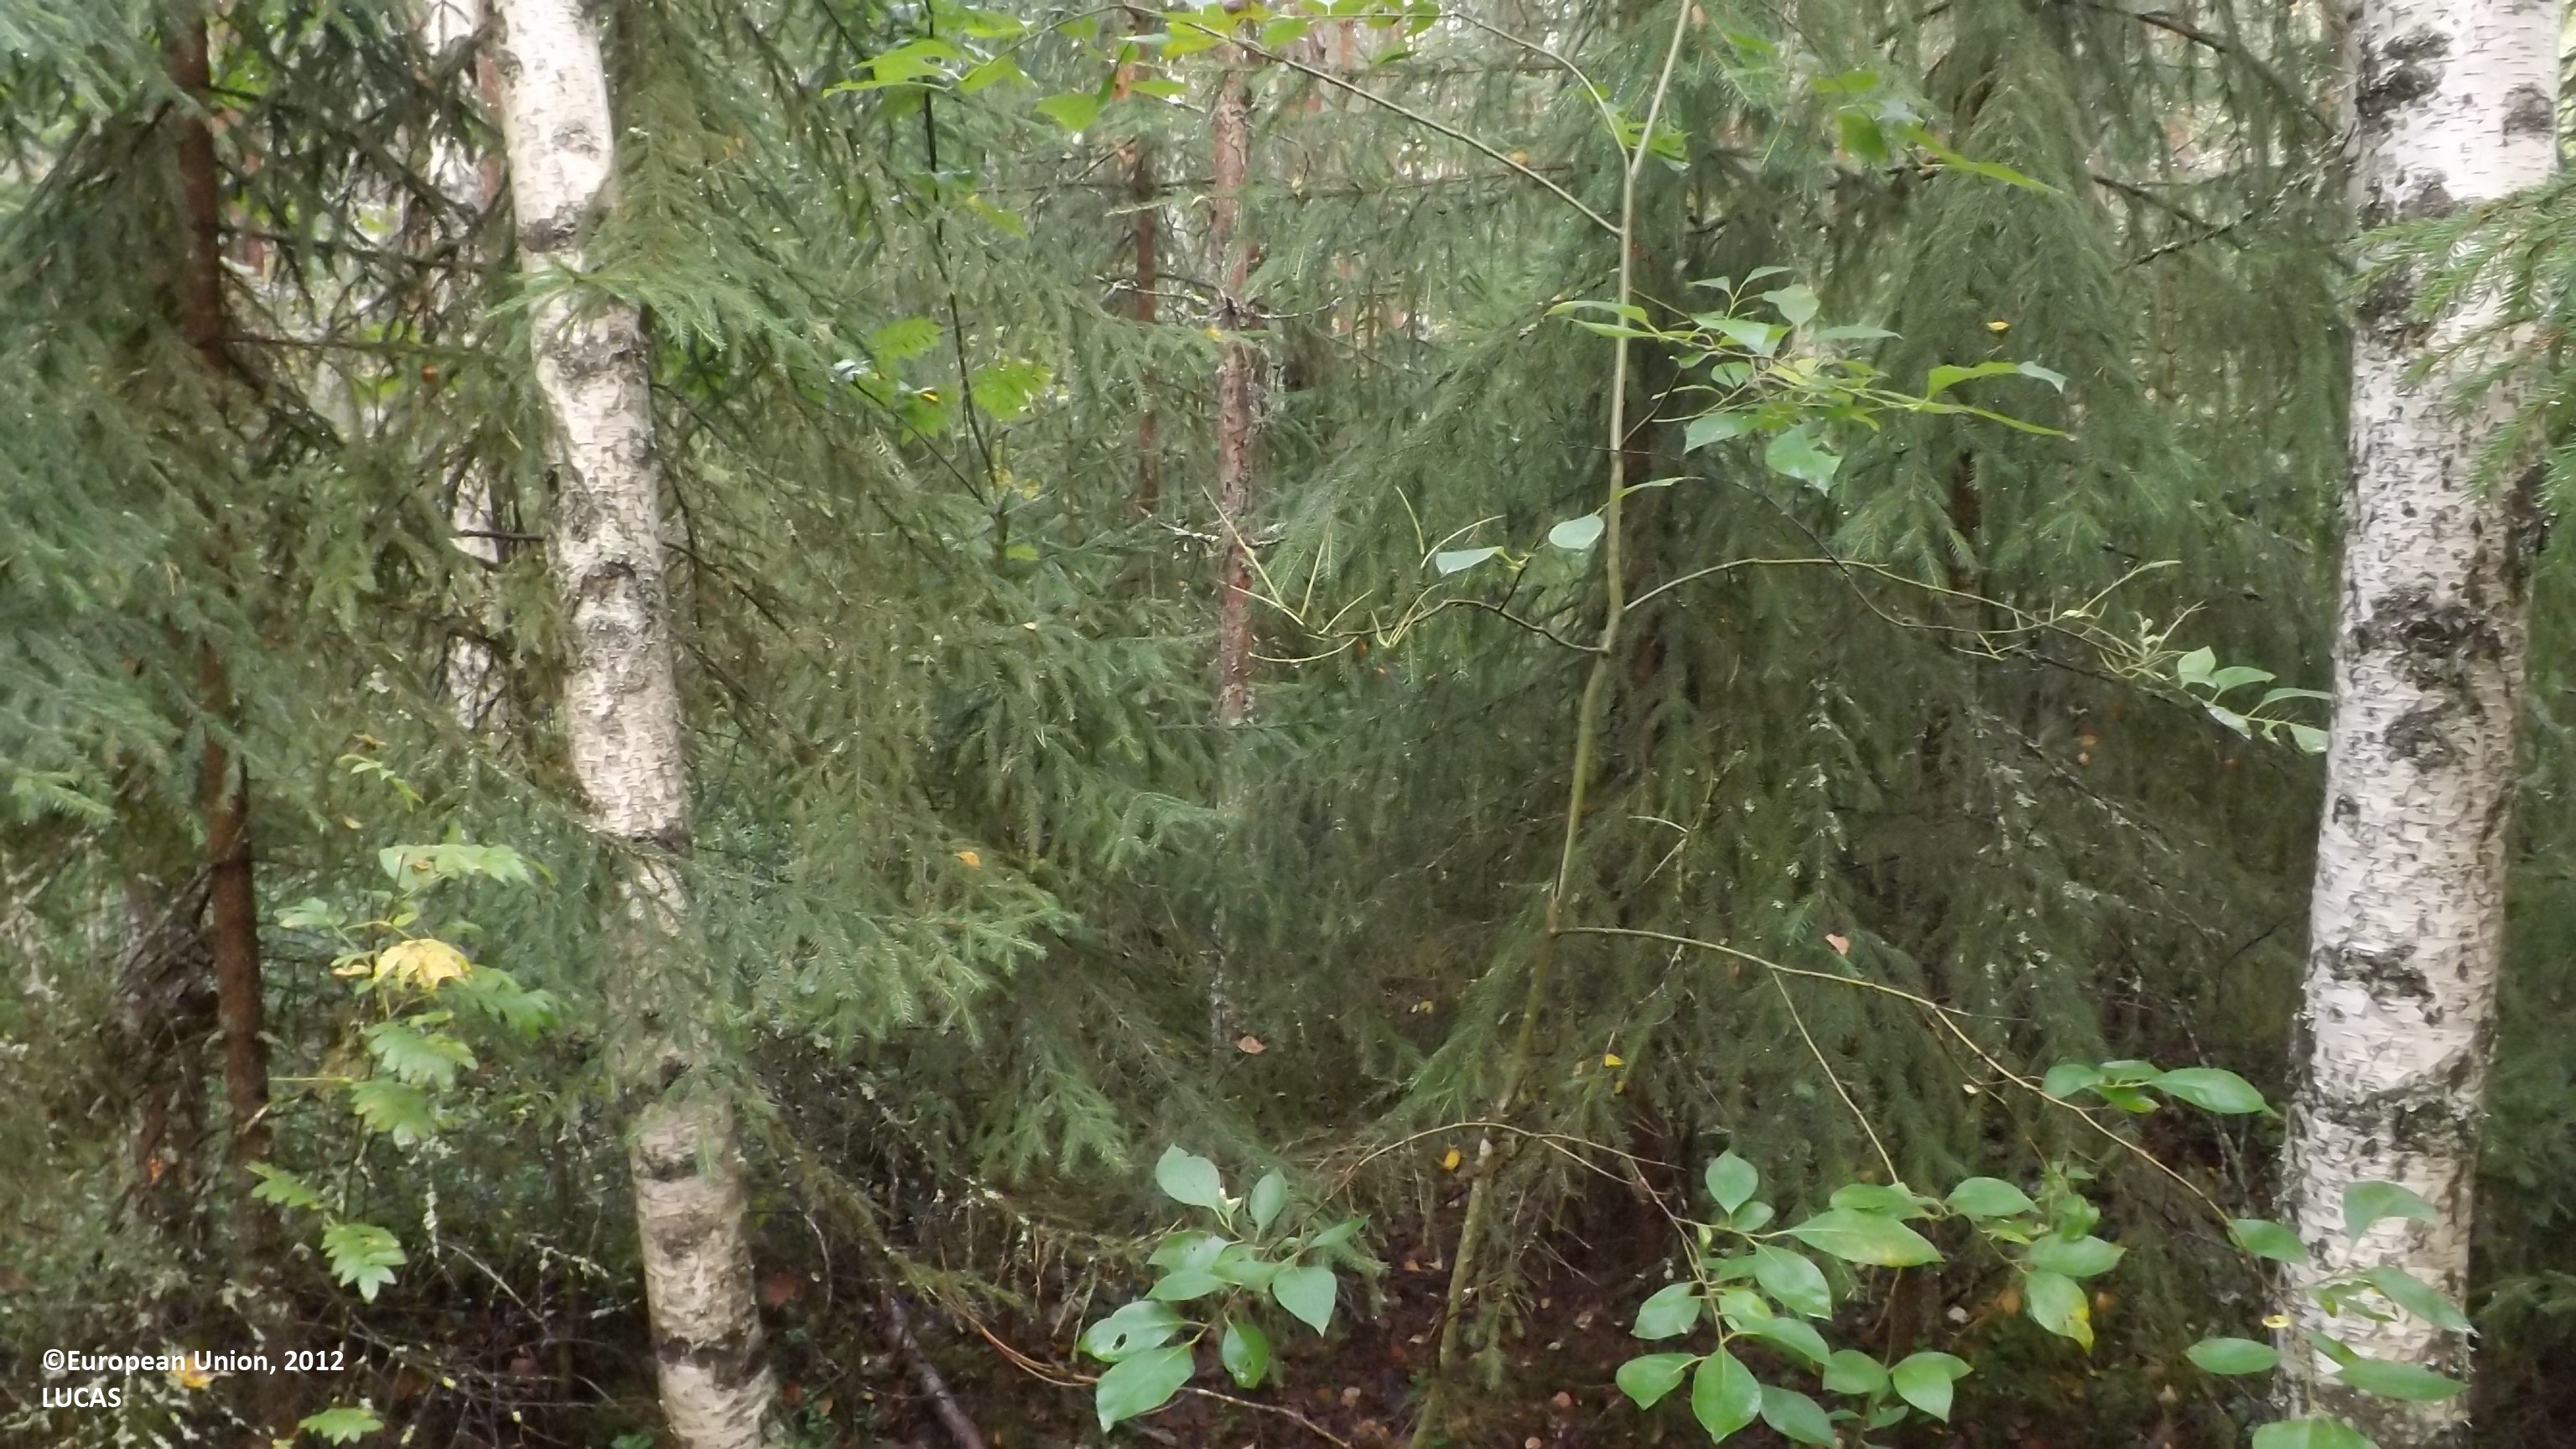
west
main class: Woodland
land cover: Other mixed woodland
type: boreal forest
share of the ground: > 75 %
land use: Forestry
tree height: > 5 m
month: August
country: FI
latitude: 63.8932
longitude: 23.4804
